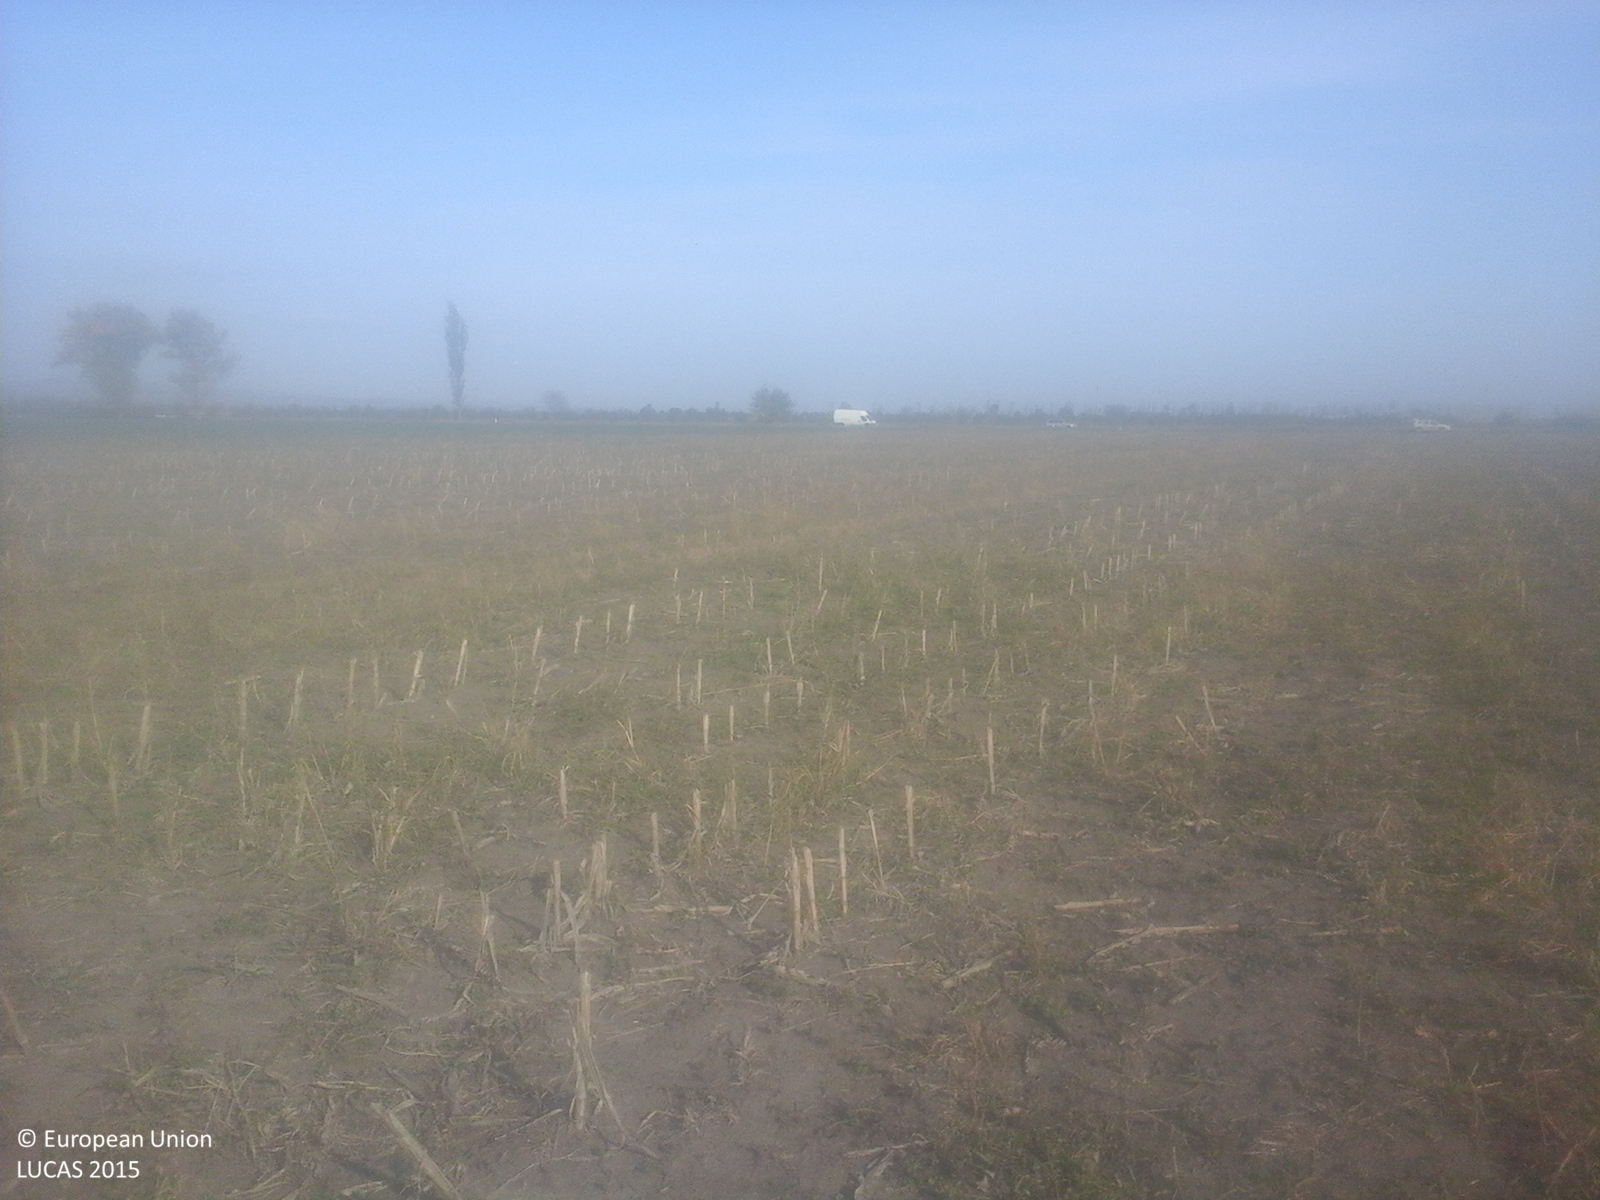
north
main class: Cropland
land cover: Maize
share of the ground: 10 - 25 %
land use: Agriculture (excluding fallow land and kitchen gardens)
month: October
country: RO
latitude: 45.3685
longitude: 27.0832
